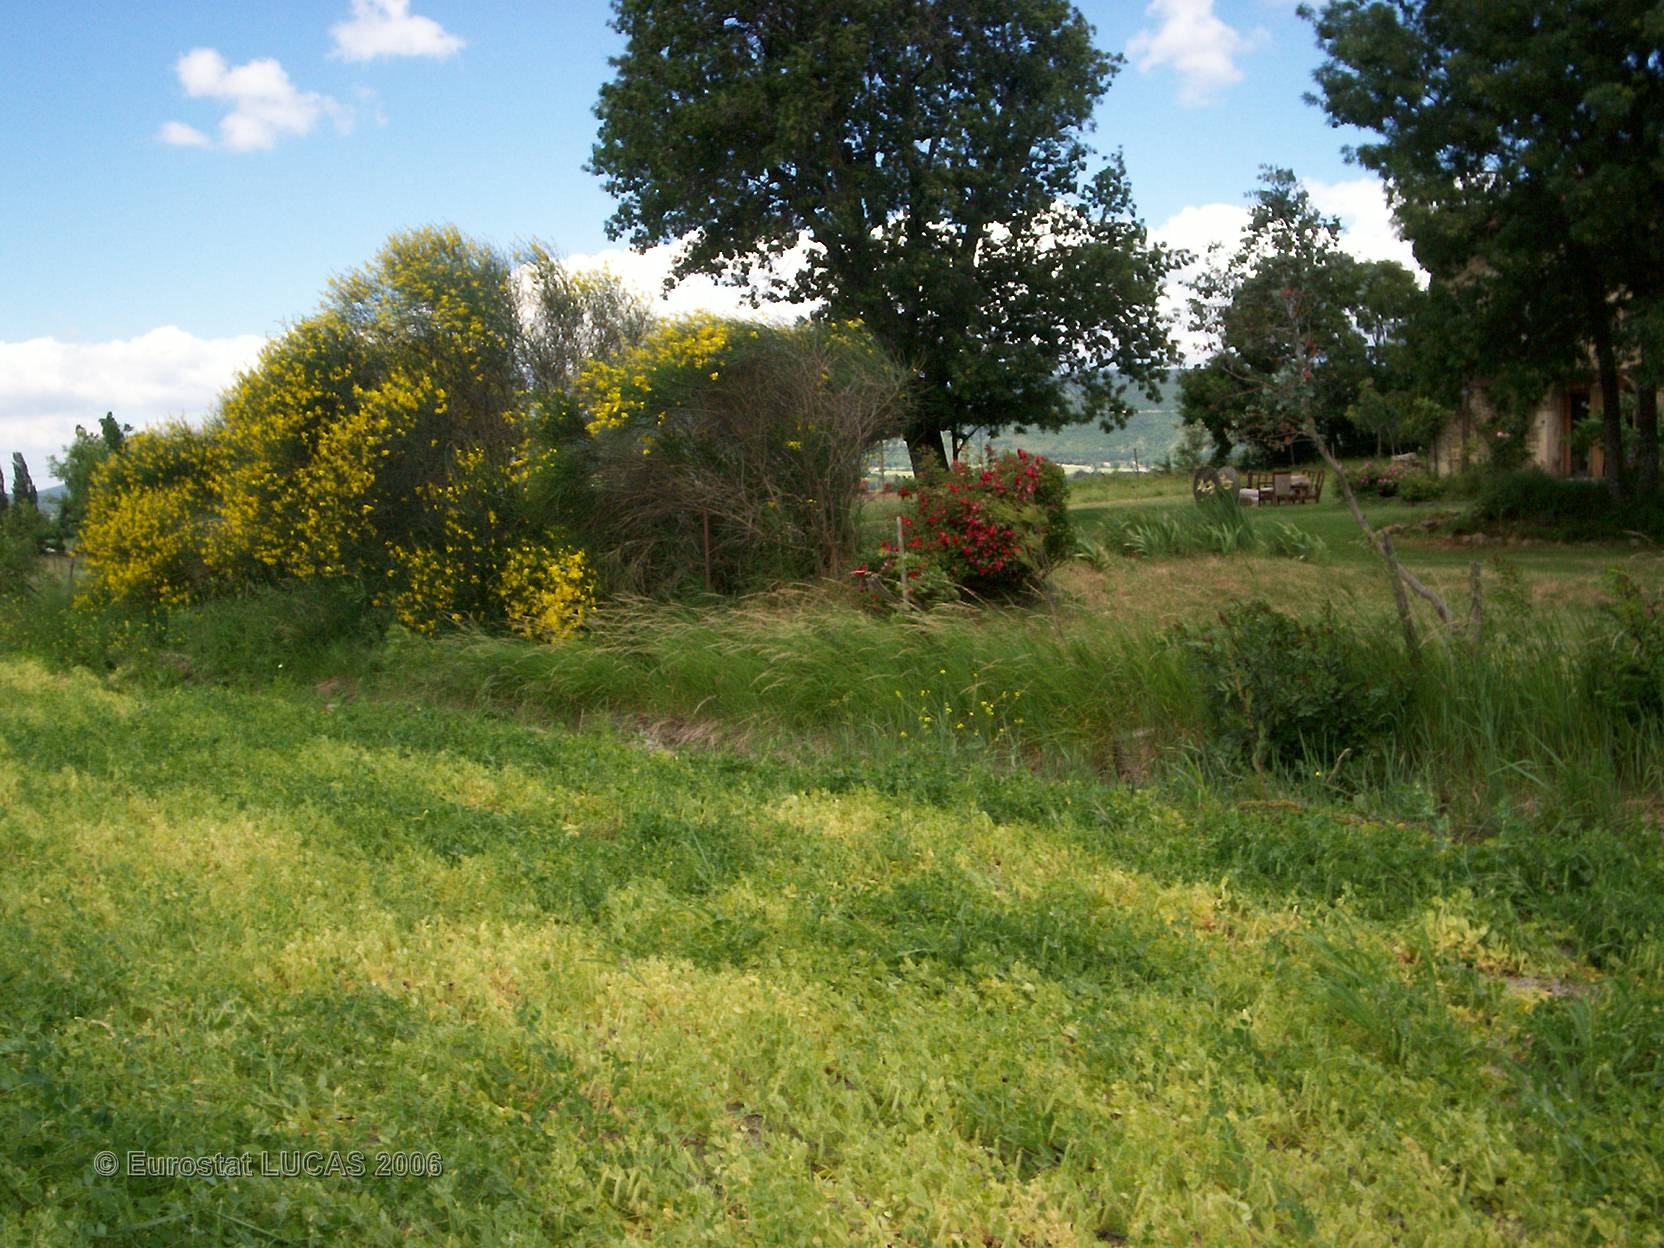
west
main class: Cropland
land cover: Dry pulses
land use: Agriculture (excluding fallow land and kitchen gardens)
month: May
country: FR
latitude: 44.6420
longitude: 4.9257
